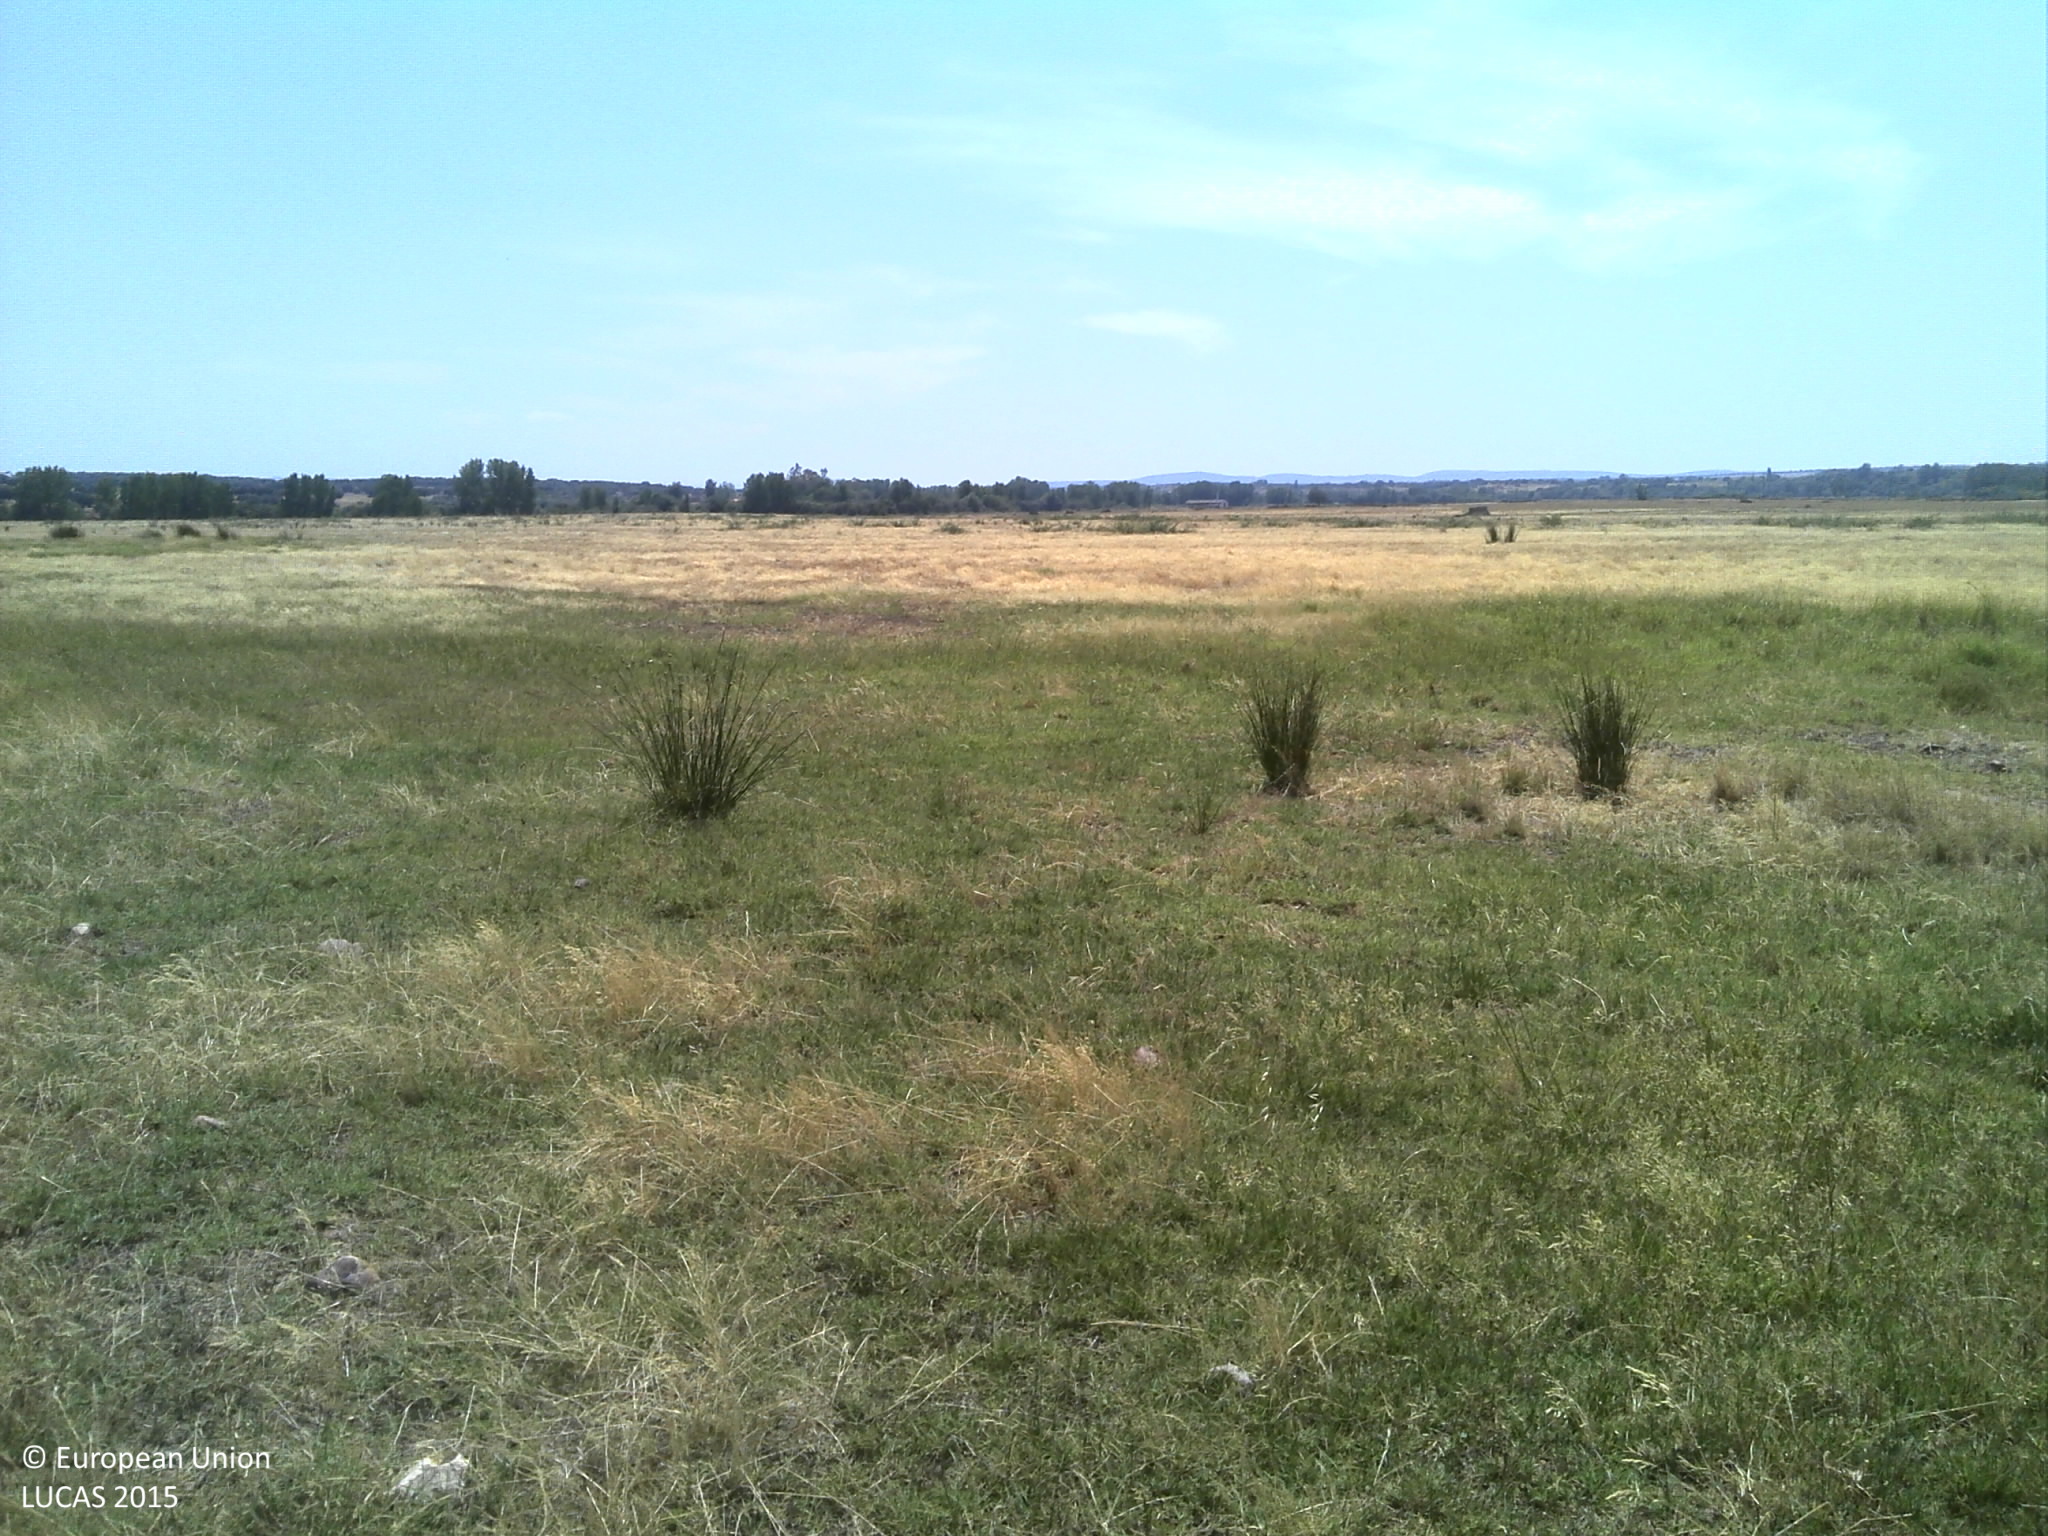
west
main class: Grassland
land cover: Grassland without tree/shrub cover
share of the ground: 50 - 75 %
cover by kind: herbaceous plants 50 %, unconsolidated bare surface 40 %, shrubs 5 %
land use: Agriculture (excluding fallow land and kitchen gardens)
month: June
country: PT
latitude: 39.8739
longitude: -7.1261
